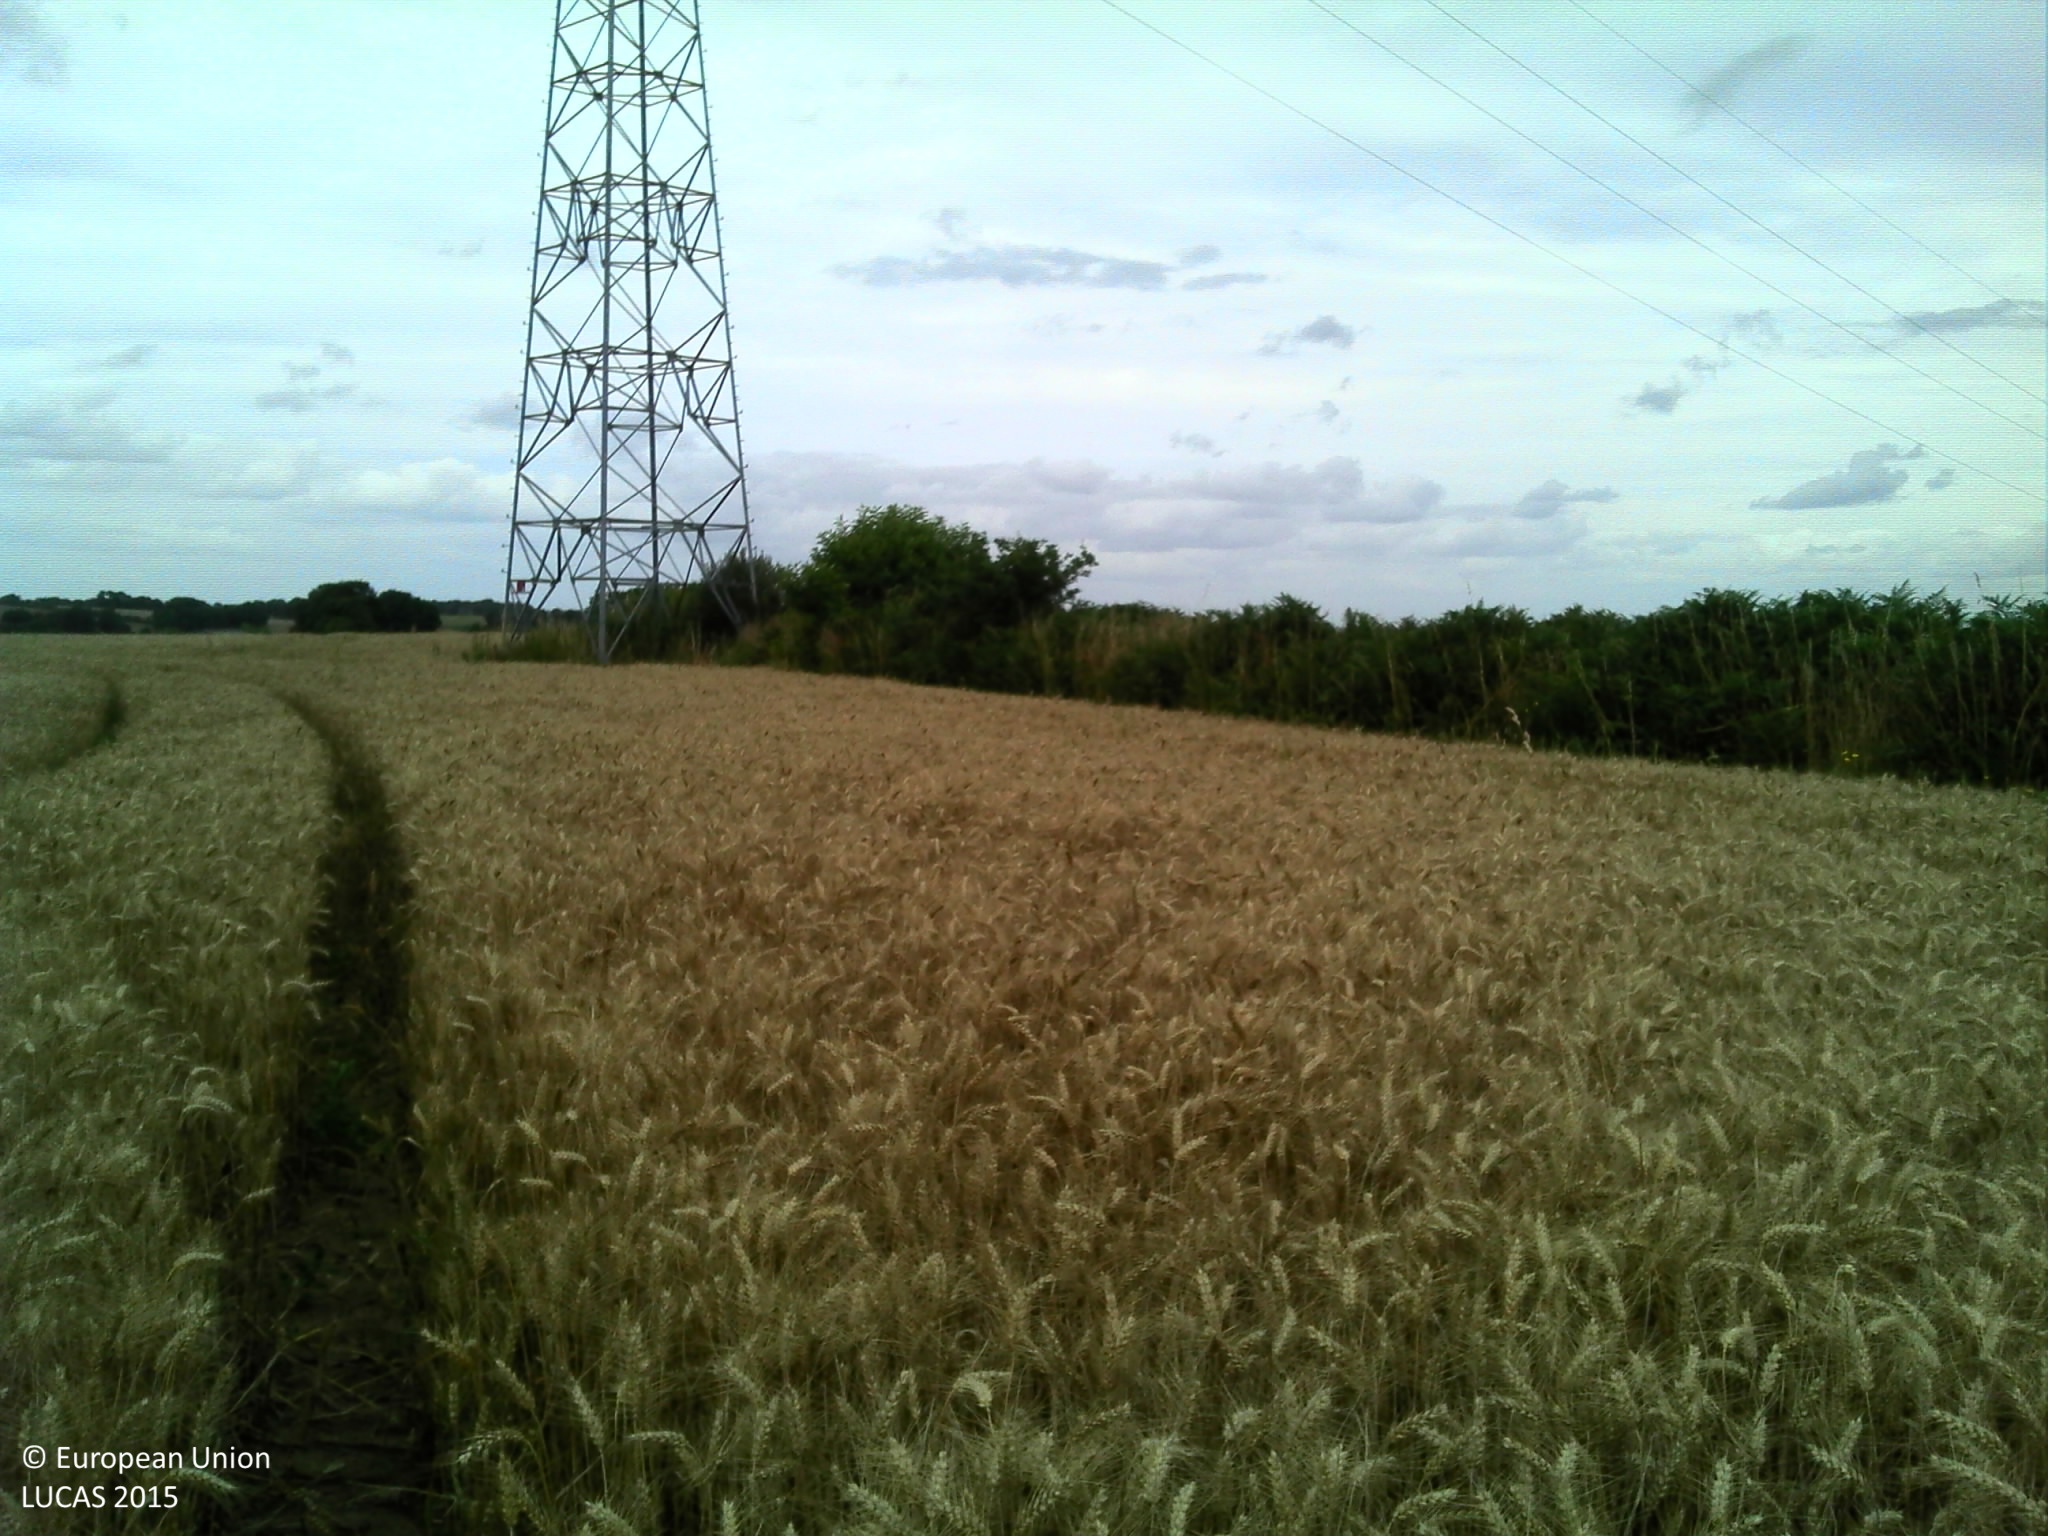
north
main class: Cropland
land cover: Common wheat
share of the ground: > 75 %
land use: Agriculture (excluding fallow land and kitchen gardens)
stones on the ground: 25 - 50 %
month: August
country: FR
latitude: 48.2601
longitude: -3.2336
